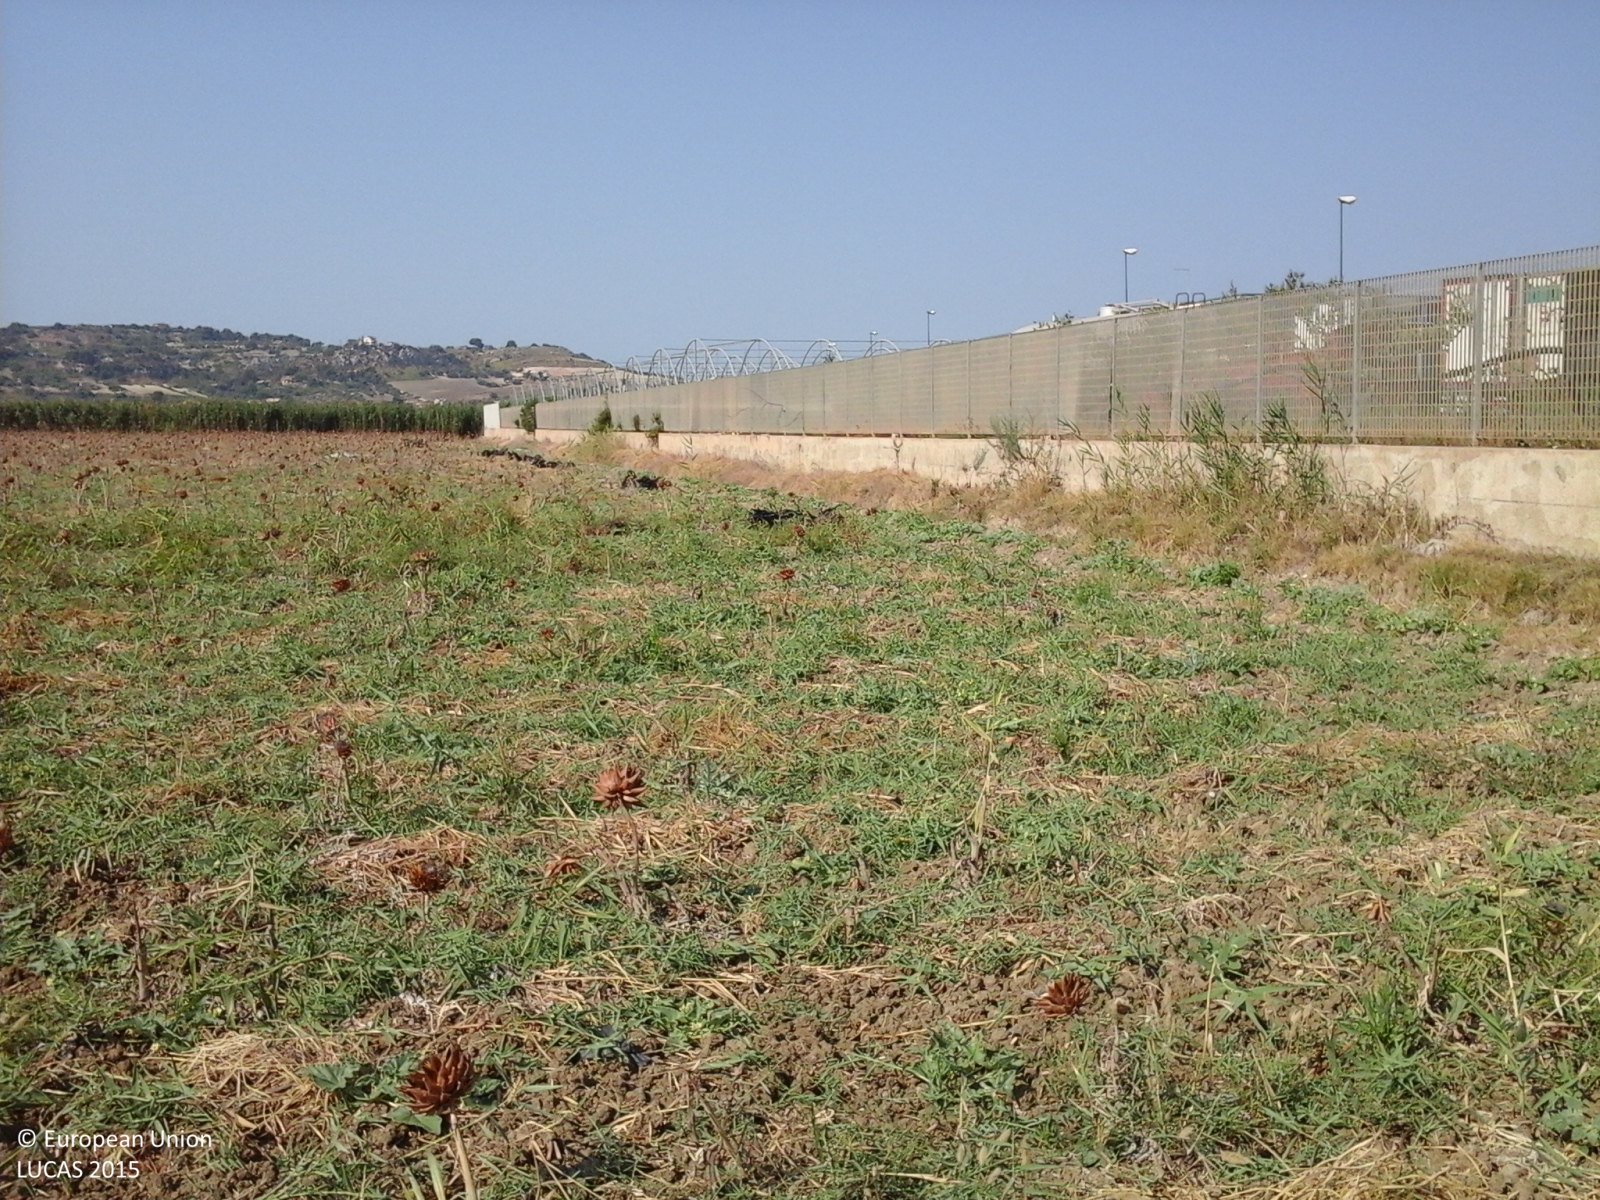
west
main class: Cropland
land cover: Other fresh vegetables
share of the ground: > 75 %
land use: Agriculture (excluding fallow land and kitchen gardens)
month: July
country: IT
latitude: 37.1223
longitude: 13.8971
